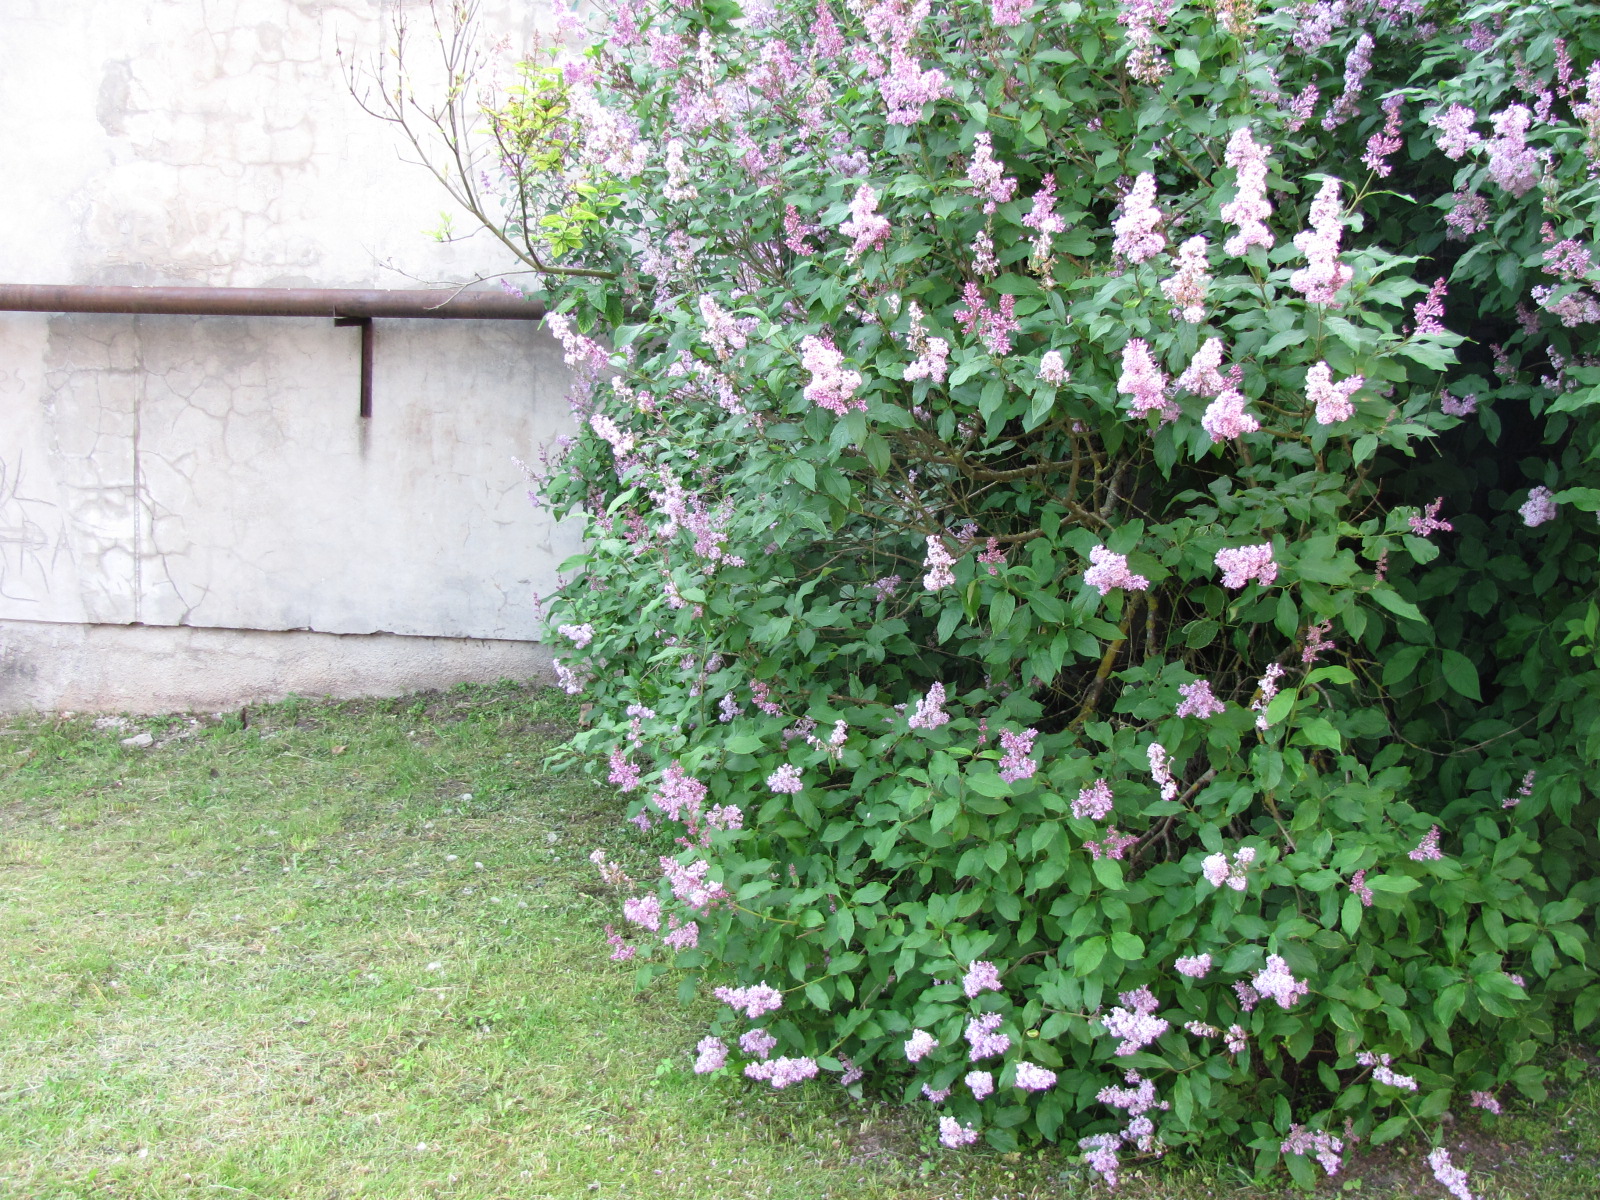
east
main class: Grassland
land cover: Grassland without tree/shrub cover
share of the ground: > 75 %
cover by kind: herbaceous plants 100 %
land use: Amenities, museums, leisure
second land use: Residential
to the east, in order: Grassland without tree/shrub cover; Artificial constructions in urban areas
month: June
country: LV
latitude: 56.3983
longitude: 24.2018
